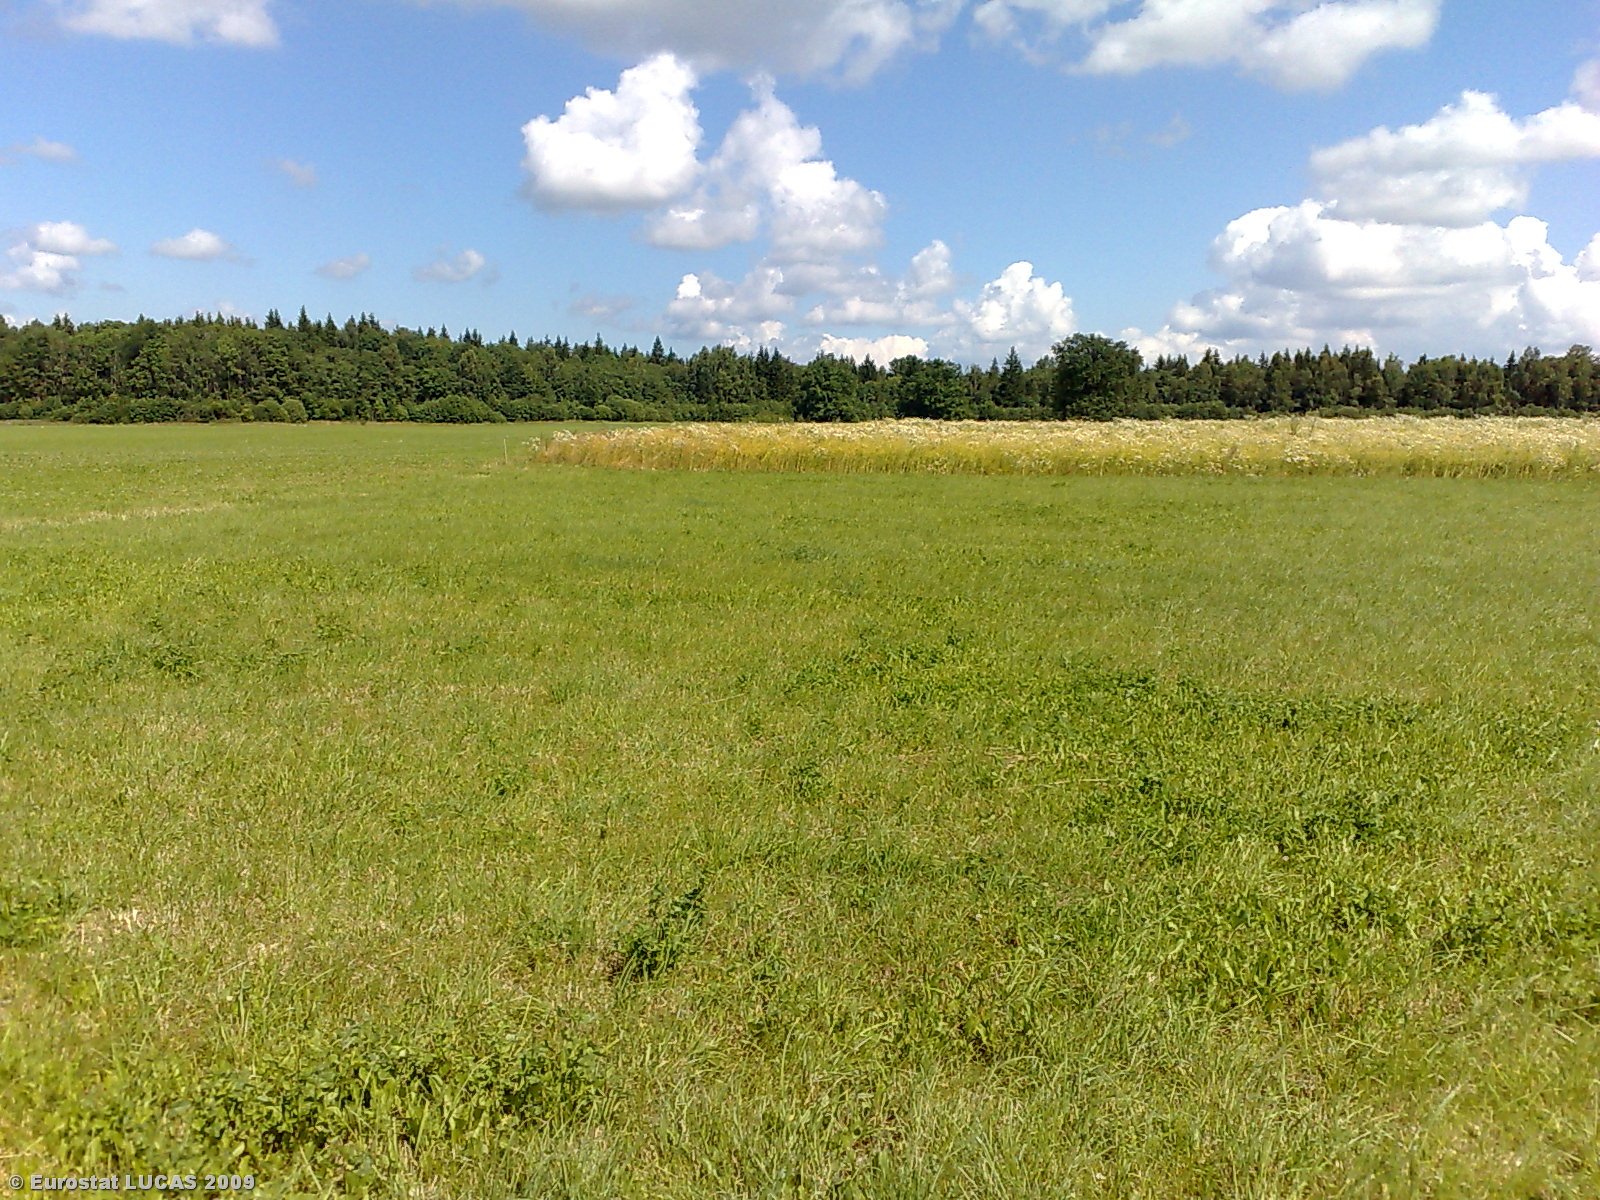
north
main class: Grassland
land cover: Grassland without tree/shrub cover
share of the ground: > 75 %
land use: Agriculture (excluding fallow land and kitchen gardens)
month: July
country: LT
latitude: 55.9354
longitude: 22.8885
